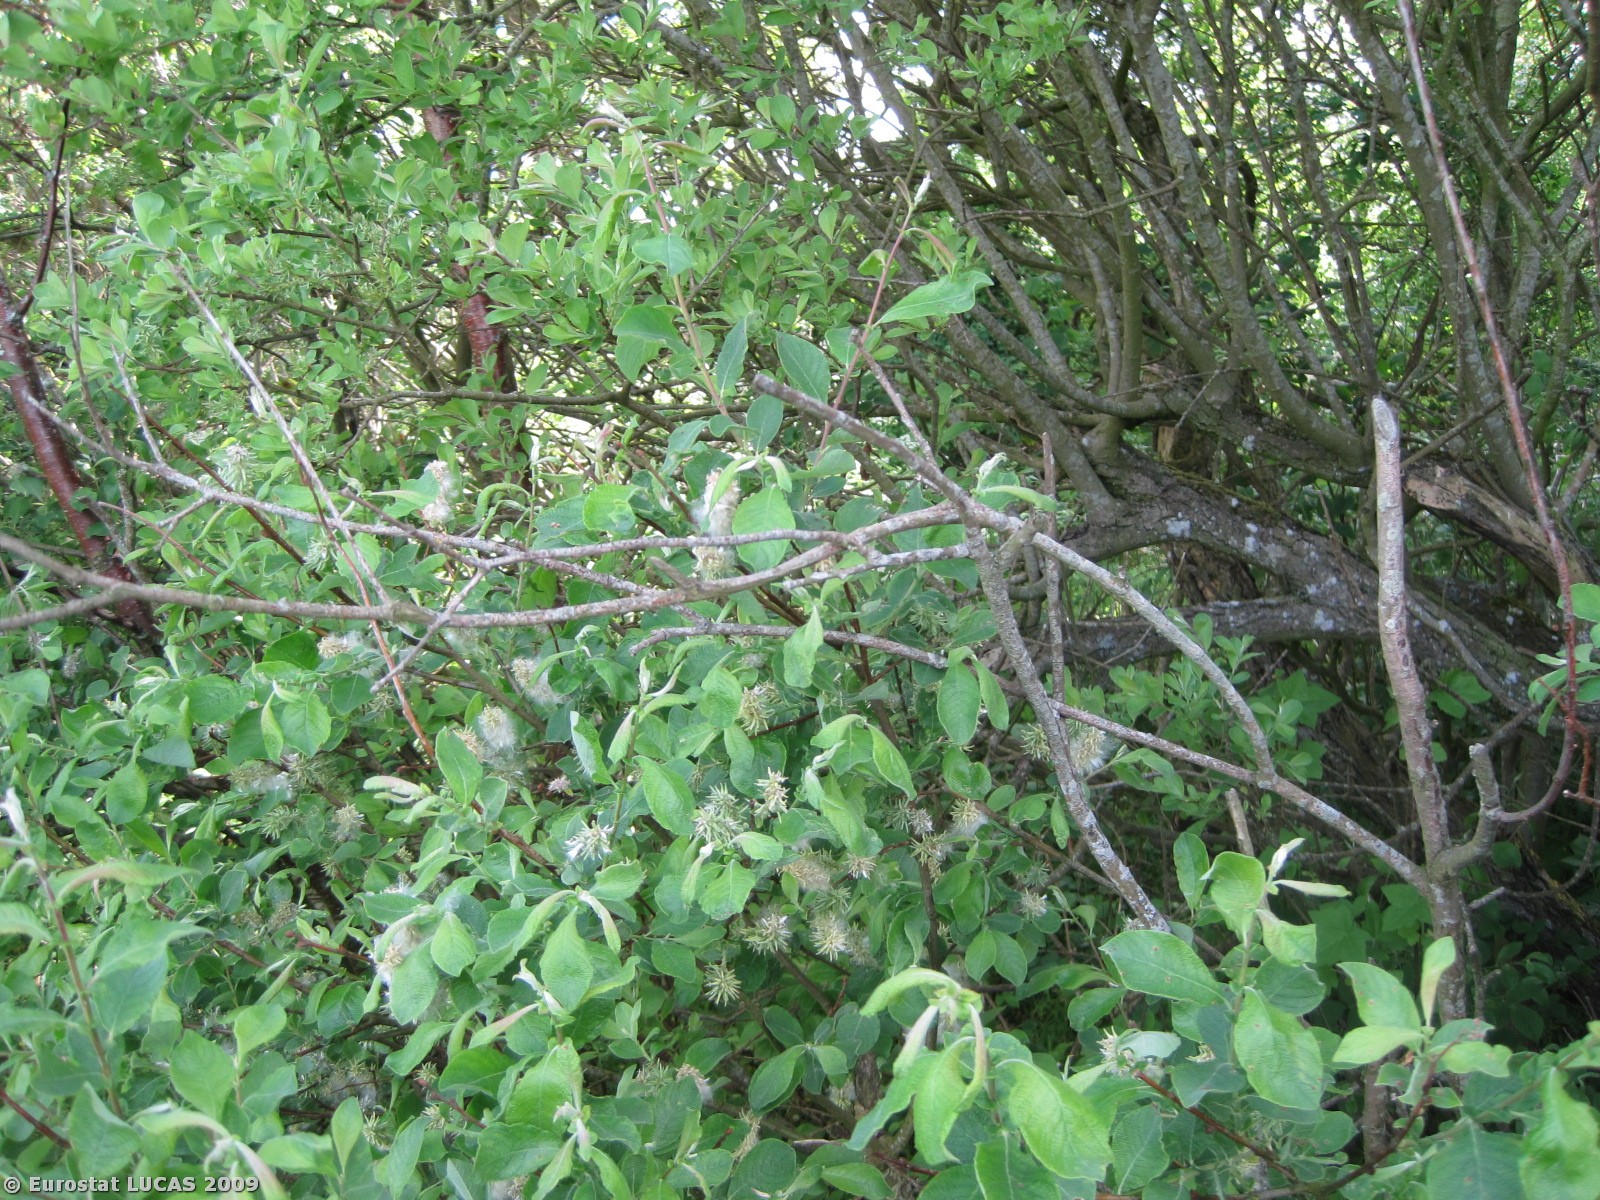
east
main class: Cropland
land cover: Rape and turnip rape
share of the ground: > 75 %
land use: Agriculture (excluding fallow land and kitchen gardens)
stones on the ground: < 10 %
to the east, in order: Rape and turnip rape; Broadleaved woodland; Grassland without tree/shrub cover; Artificial constructions in urban areas; Grassland without tree/shrub cover; Artificial constructions in urban areas; Tracks; Grassland without tree/shrub cover; Broadleaved woodland; Shrubland with sparse tree cover; Grass margins; Tracks; Grass margins; Broadleaved woodland
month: June
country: DK
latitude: 56.9426
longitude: 10.2134
